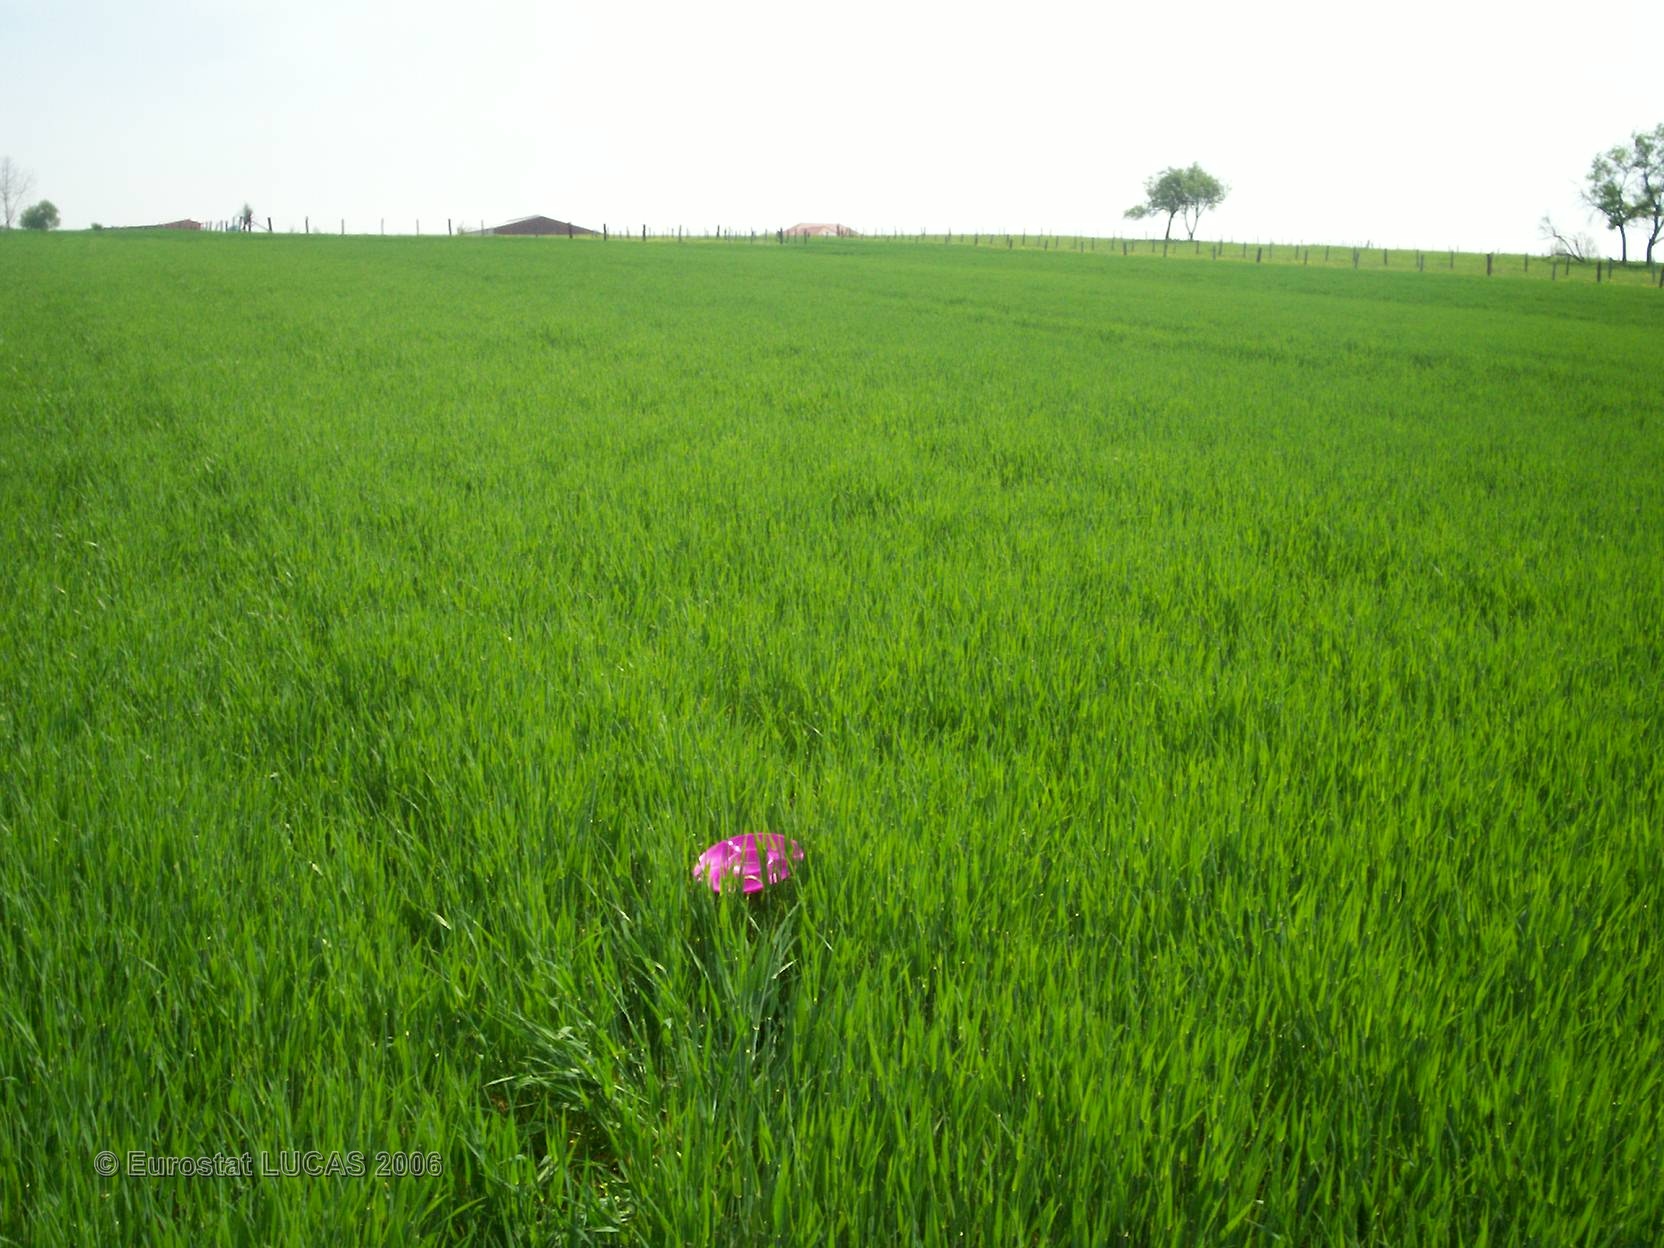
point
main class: Cropland
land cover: Barley
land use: Agriculture (excluding fallow land and kitchen gardens)
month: May
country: FR
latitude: 48.9392
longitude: 7.0106
